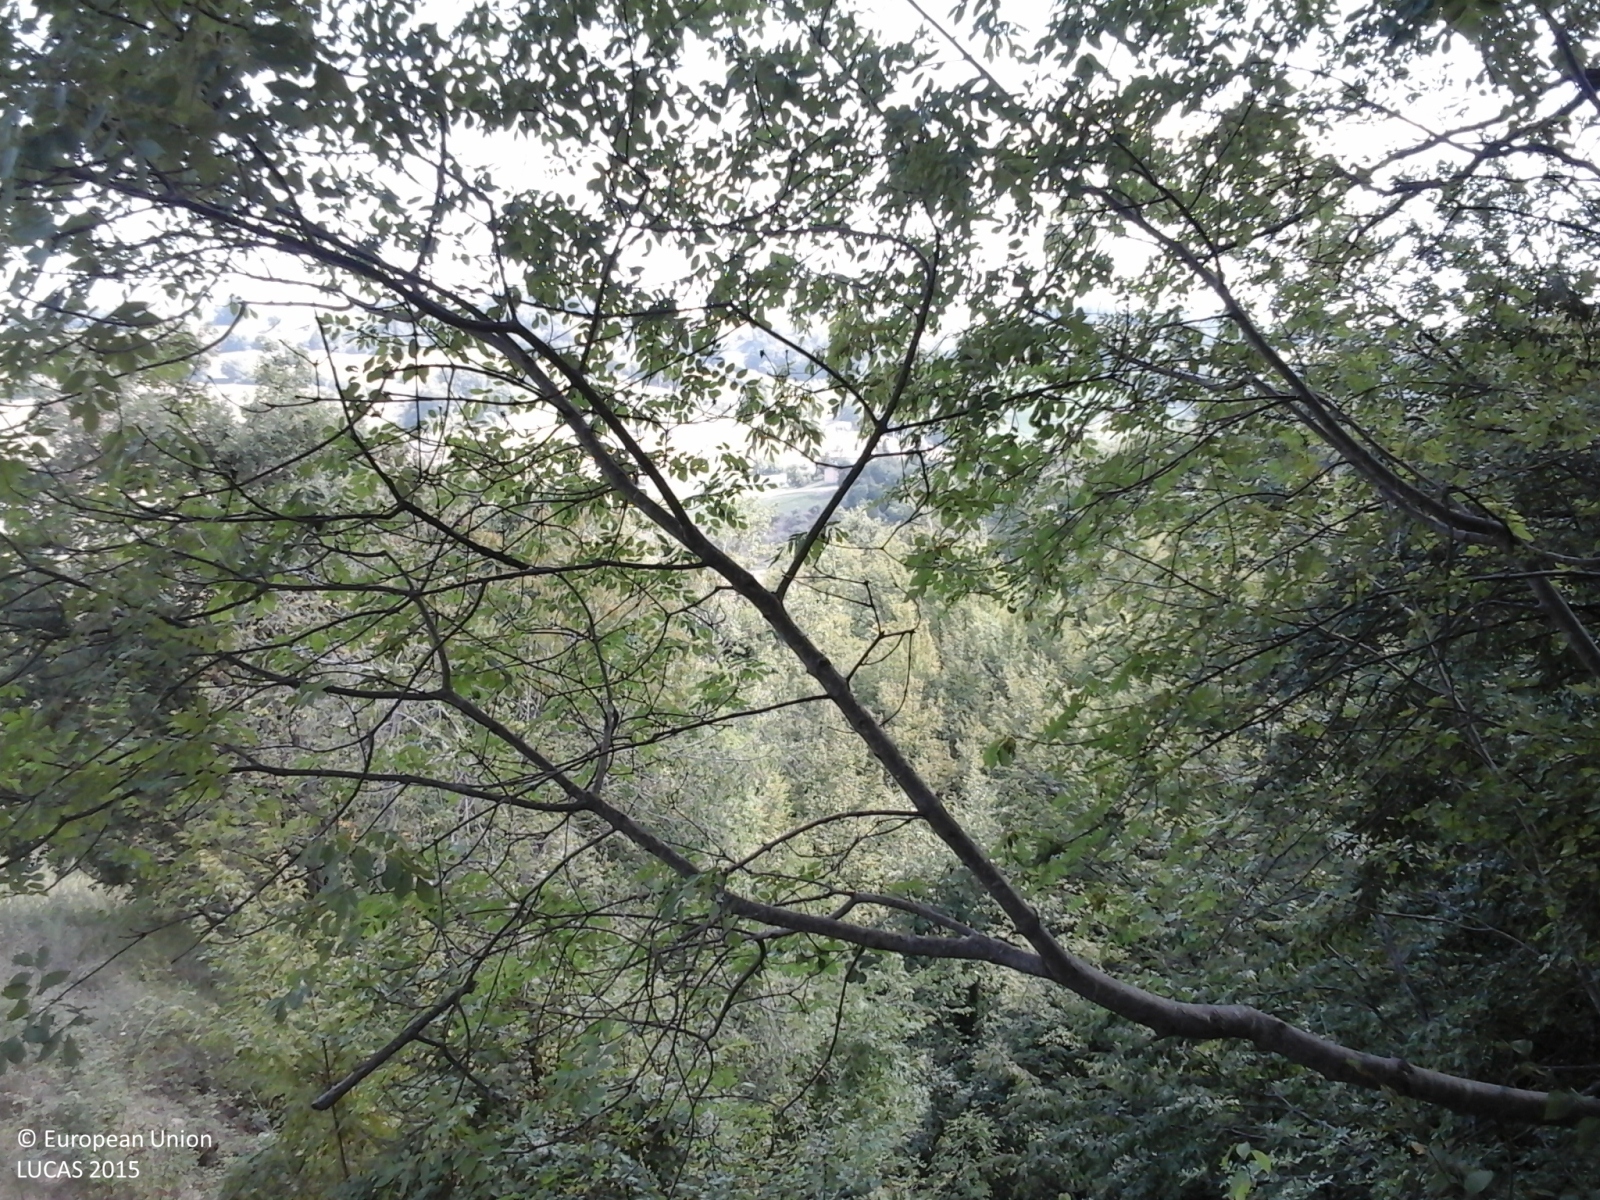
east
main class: Woodland
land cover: Broadleaved woodland
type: thermophilous deciduous forest
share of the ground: > 75 %
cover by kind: broadleaved forest trees 80 %, shrubs 10 %, herbaceous plants 10 %
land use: Semi-natural and natural areas not in use
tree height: > 5 m
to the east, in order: Broadleaved woodland; Other bare soil; Broadleaved woodland; Other bare soil
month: September
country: IT
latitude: 42.5105
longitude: 13.7979
